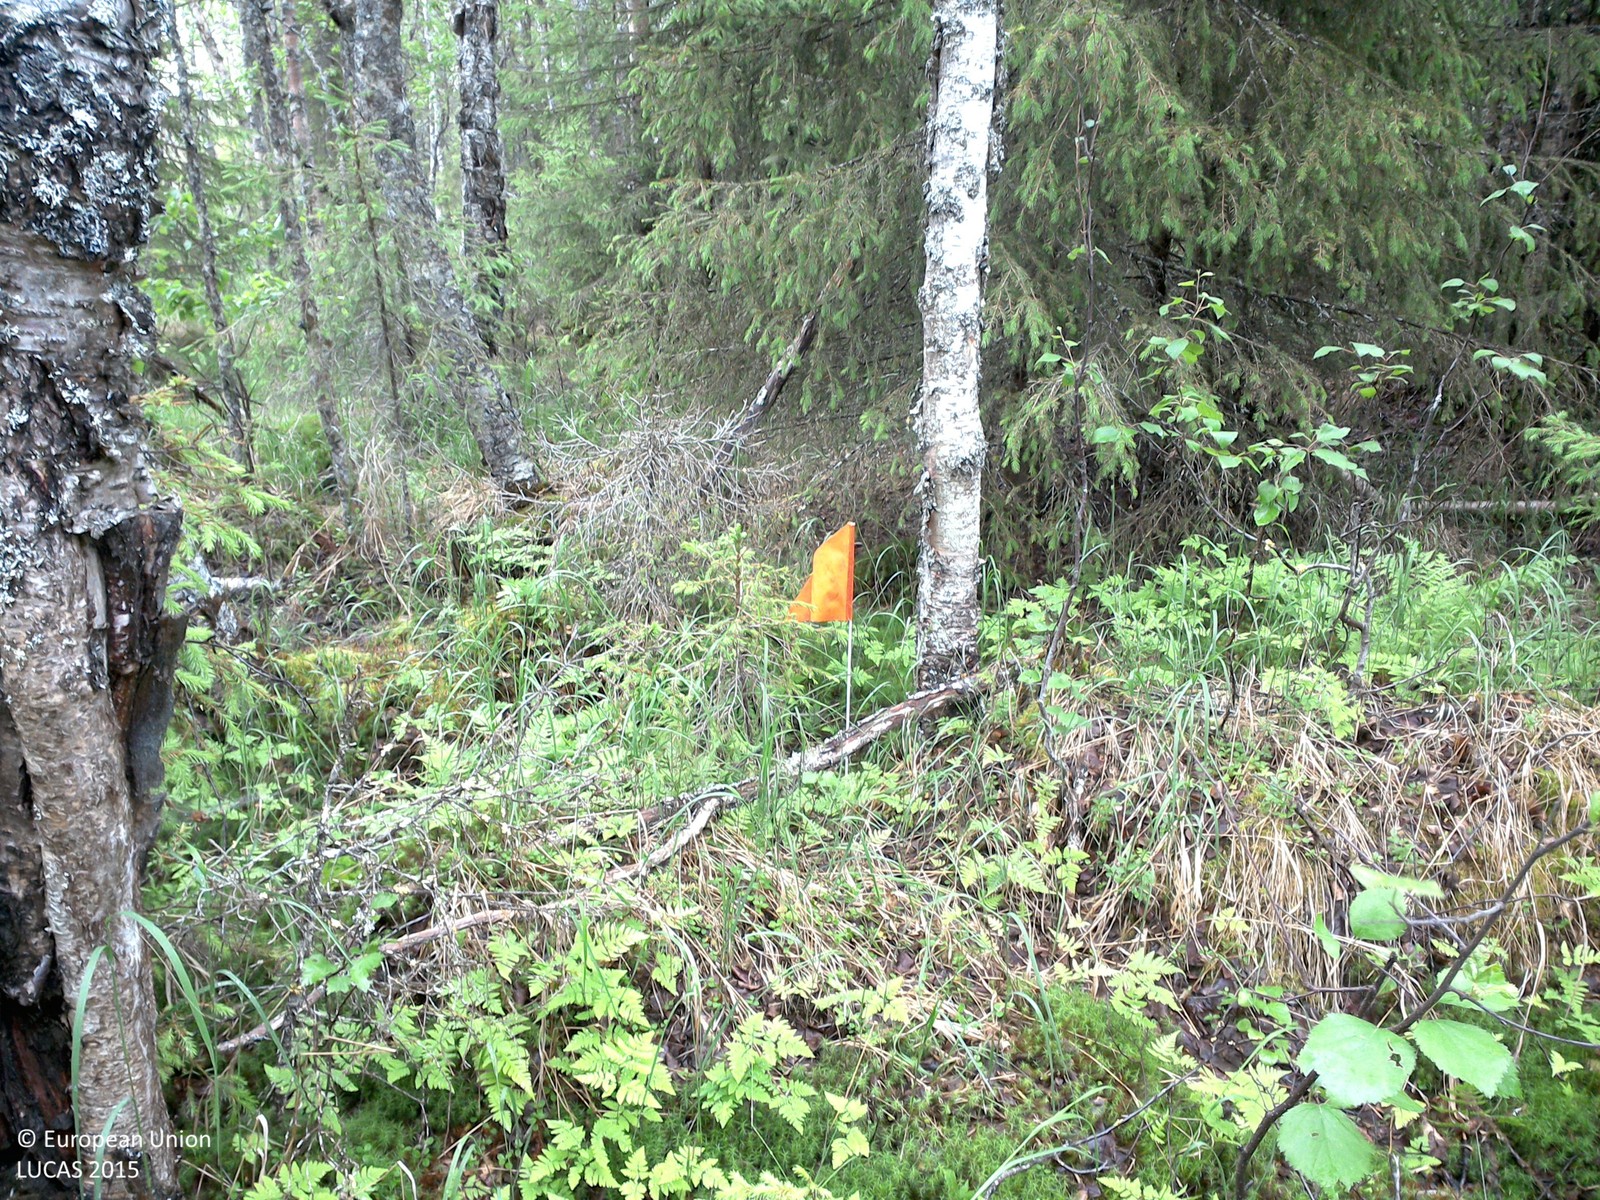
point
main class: Woodland
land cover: Other mixed woodland
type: boreal forest
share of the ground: 25 - 50 %
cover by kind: lichens and mosses 35 %, broadleaved forest trees 30 %, herbaceous plants 25 %, coniferous forest trees 10 %
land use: Forestry
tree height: > 5 m
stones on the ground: < 10 %
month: July
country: SE
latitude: 67.0145
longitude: 23.5860
